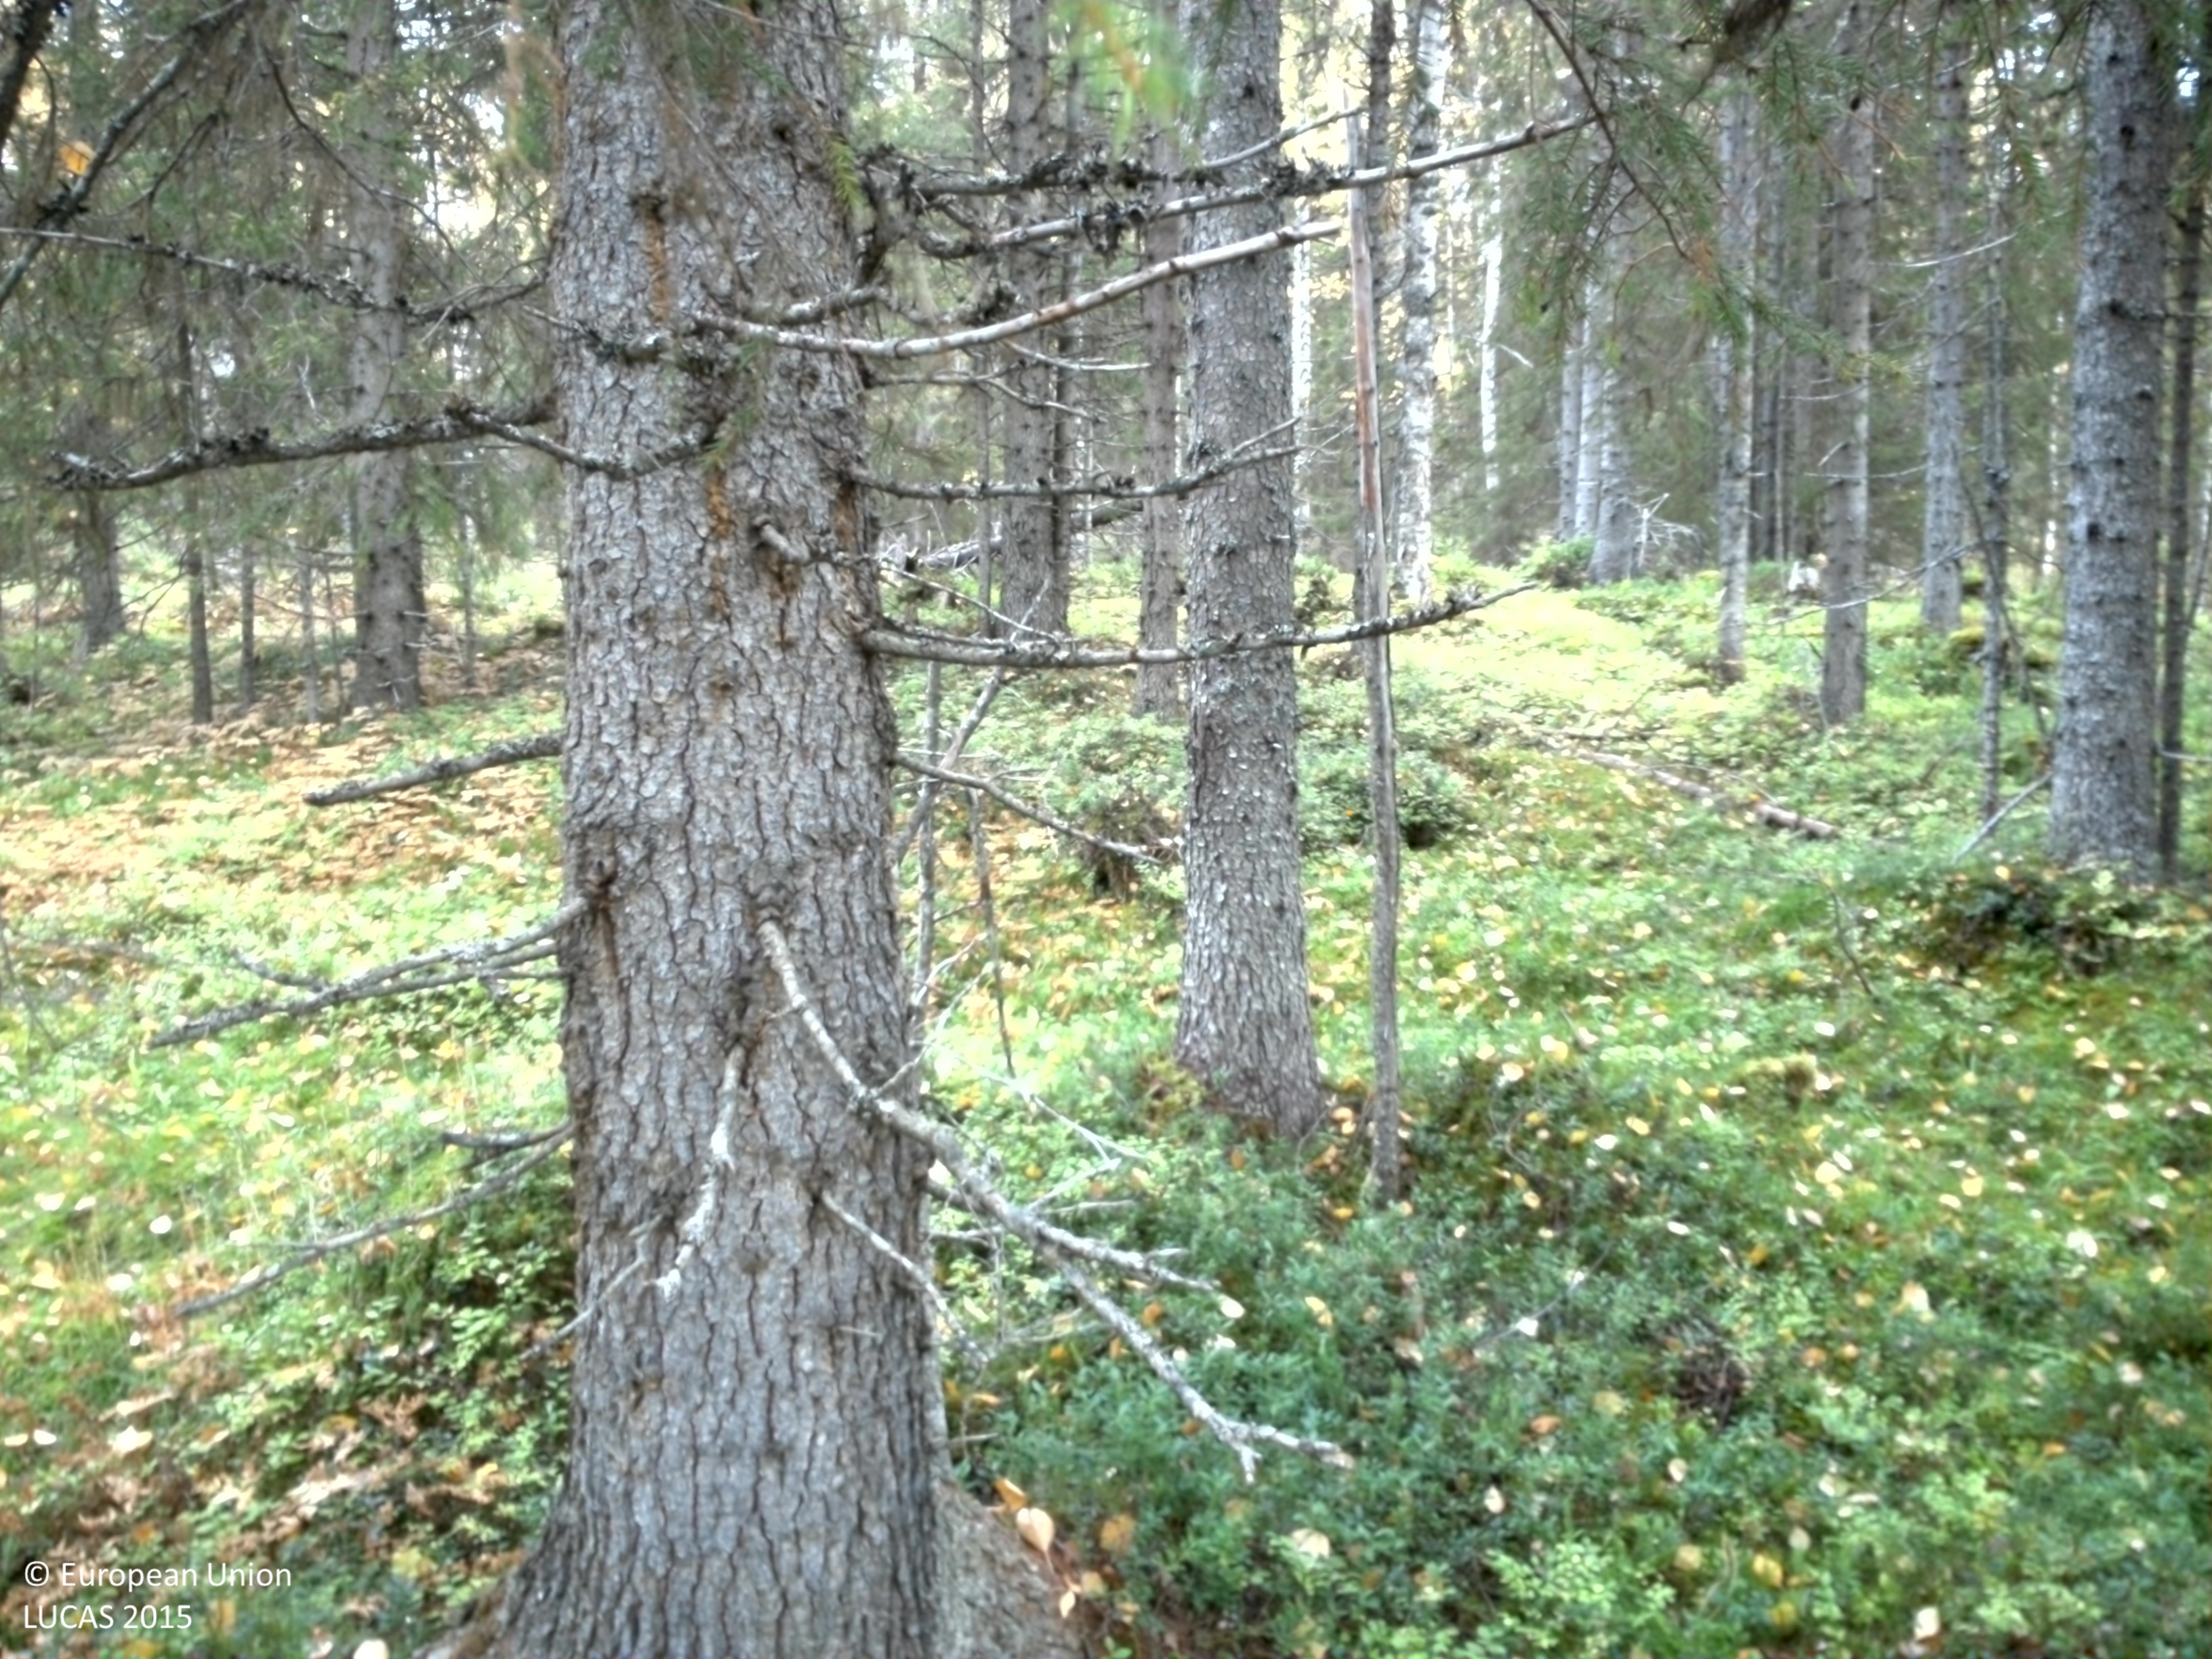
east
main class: Woodland
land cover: Spruce dominated mixed woodland
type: boreal forest
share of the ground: 50 - 75 %
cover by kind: coniferous forest trees 35 %, shrubs 20 %, herbaceous plants 20 %, broadleaved forest trees 15 %, lichens and mosses 10 %
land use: Forestry
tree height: > 5 m
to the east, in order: Spruce dominated mixed woodland; Spruce dominated coniferous woodland; Broadleaved woodland; Shruby margins; Paved roads, cycling and walking lanes; Shruby margins; Ditches and canals; Shrubland with sparse tree cover; Spruce dominated mixed woodland; Spruce dominated coniferous woodland; Spruce dominated mixed woodland
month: September
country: SE
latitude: 65.1215
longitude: 17.6532
